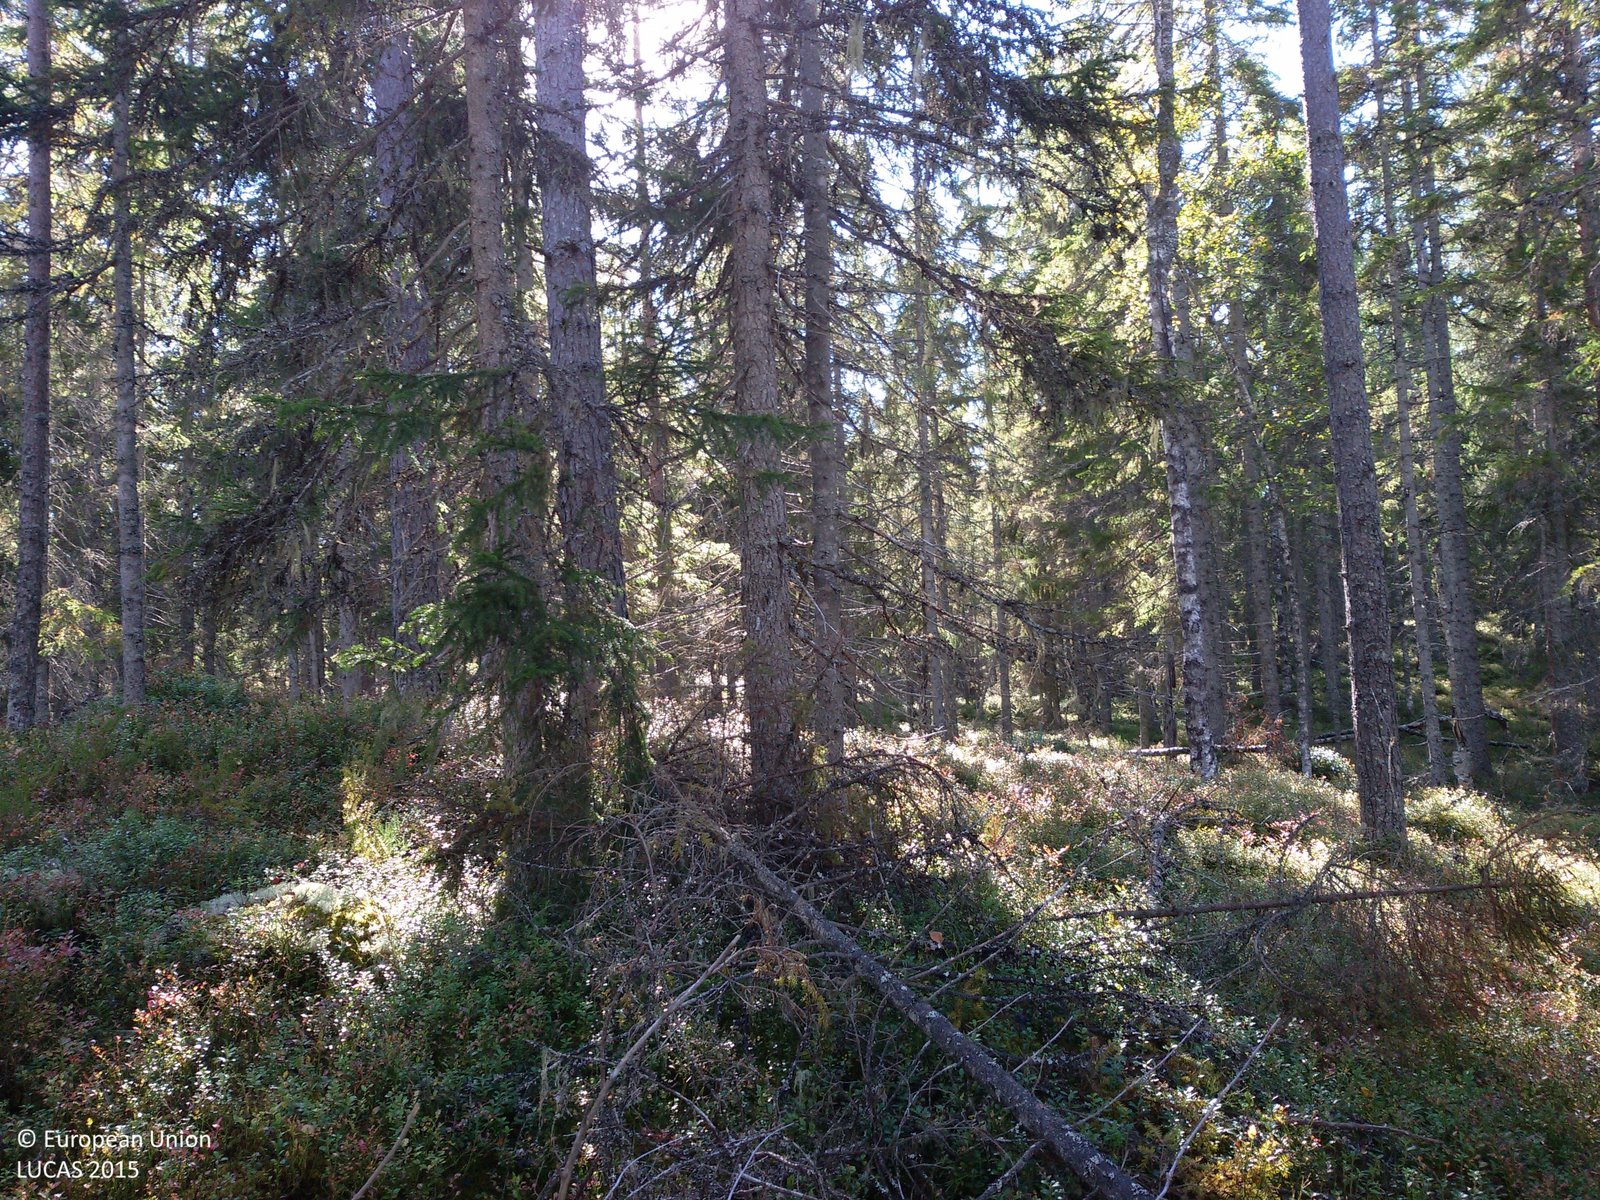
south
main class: Woodland
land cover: Other coniferous woodland
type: boreal forest
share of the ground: 50 - 75 %
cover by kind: coniferous forest trees 60 %, shrubs 30 %, lichens and mosses 10 %
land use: Forestry
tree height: > 5 m
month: September
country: SE
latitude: 60.7373
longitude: 14.5906
